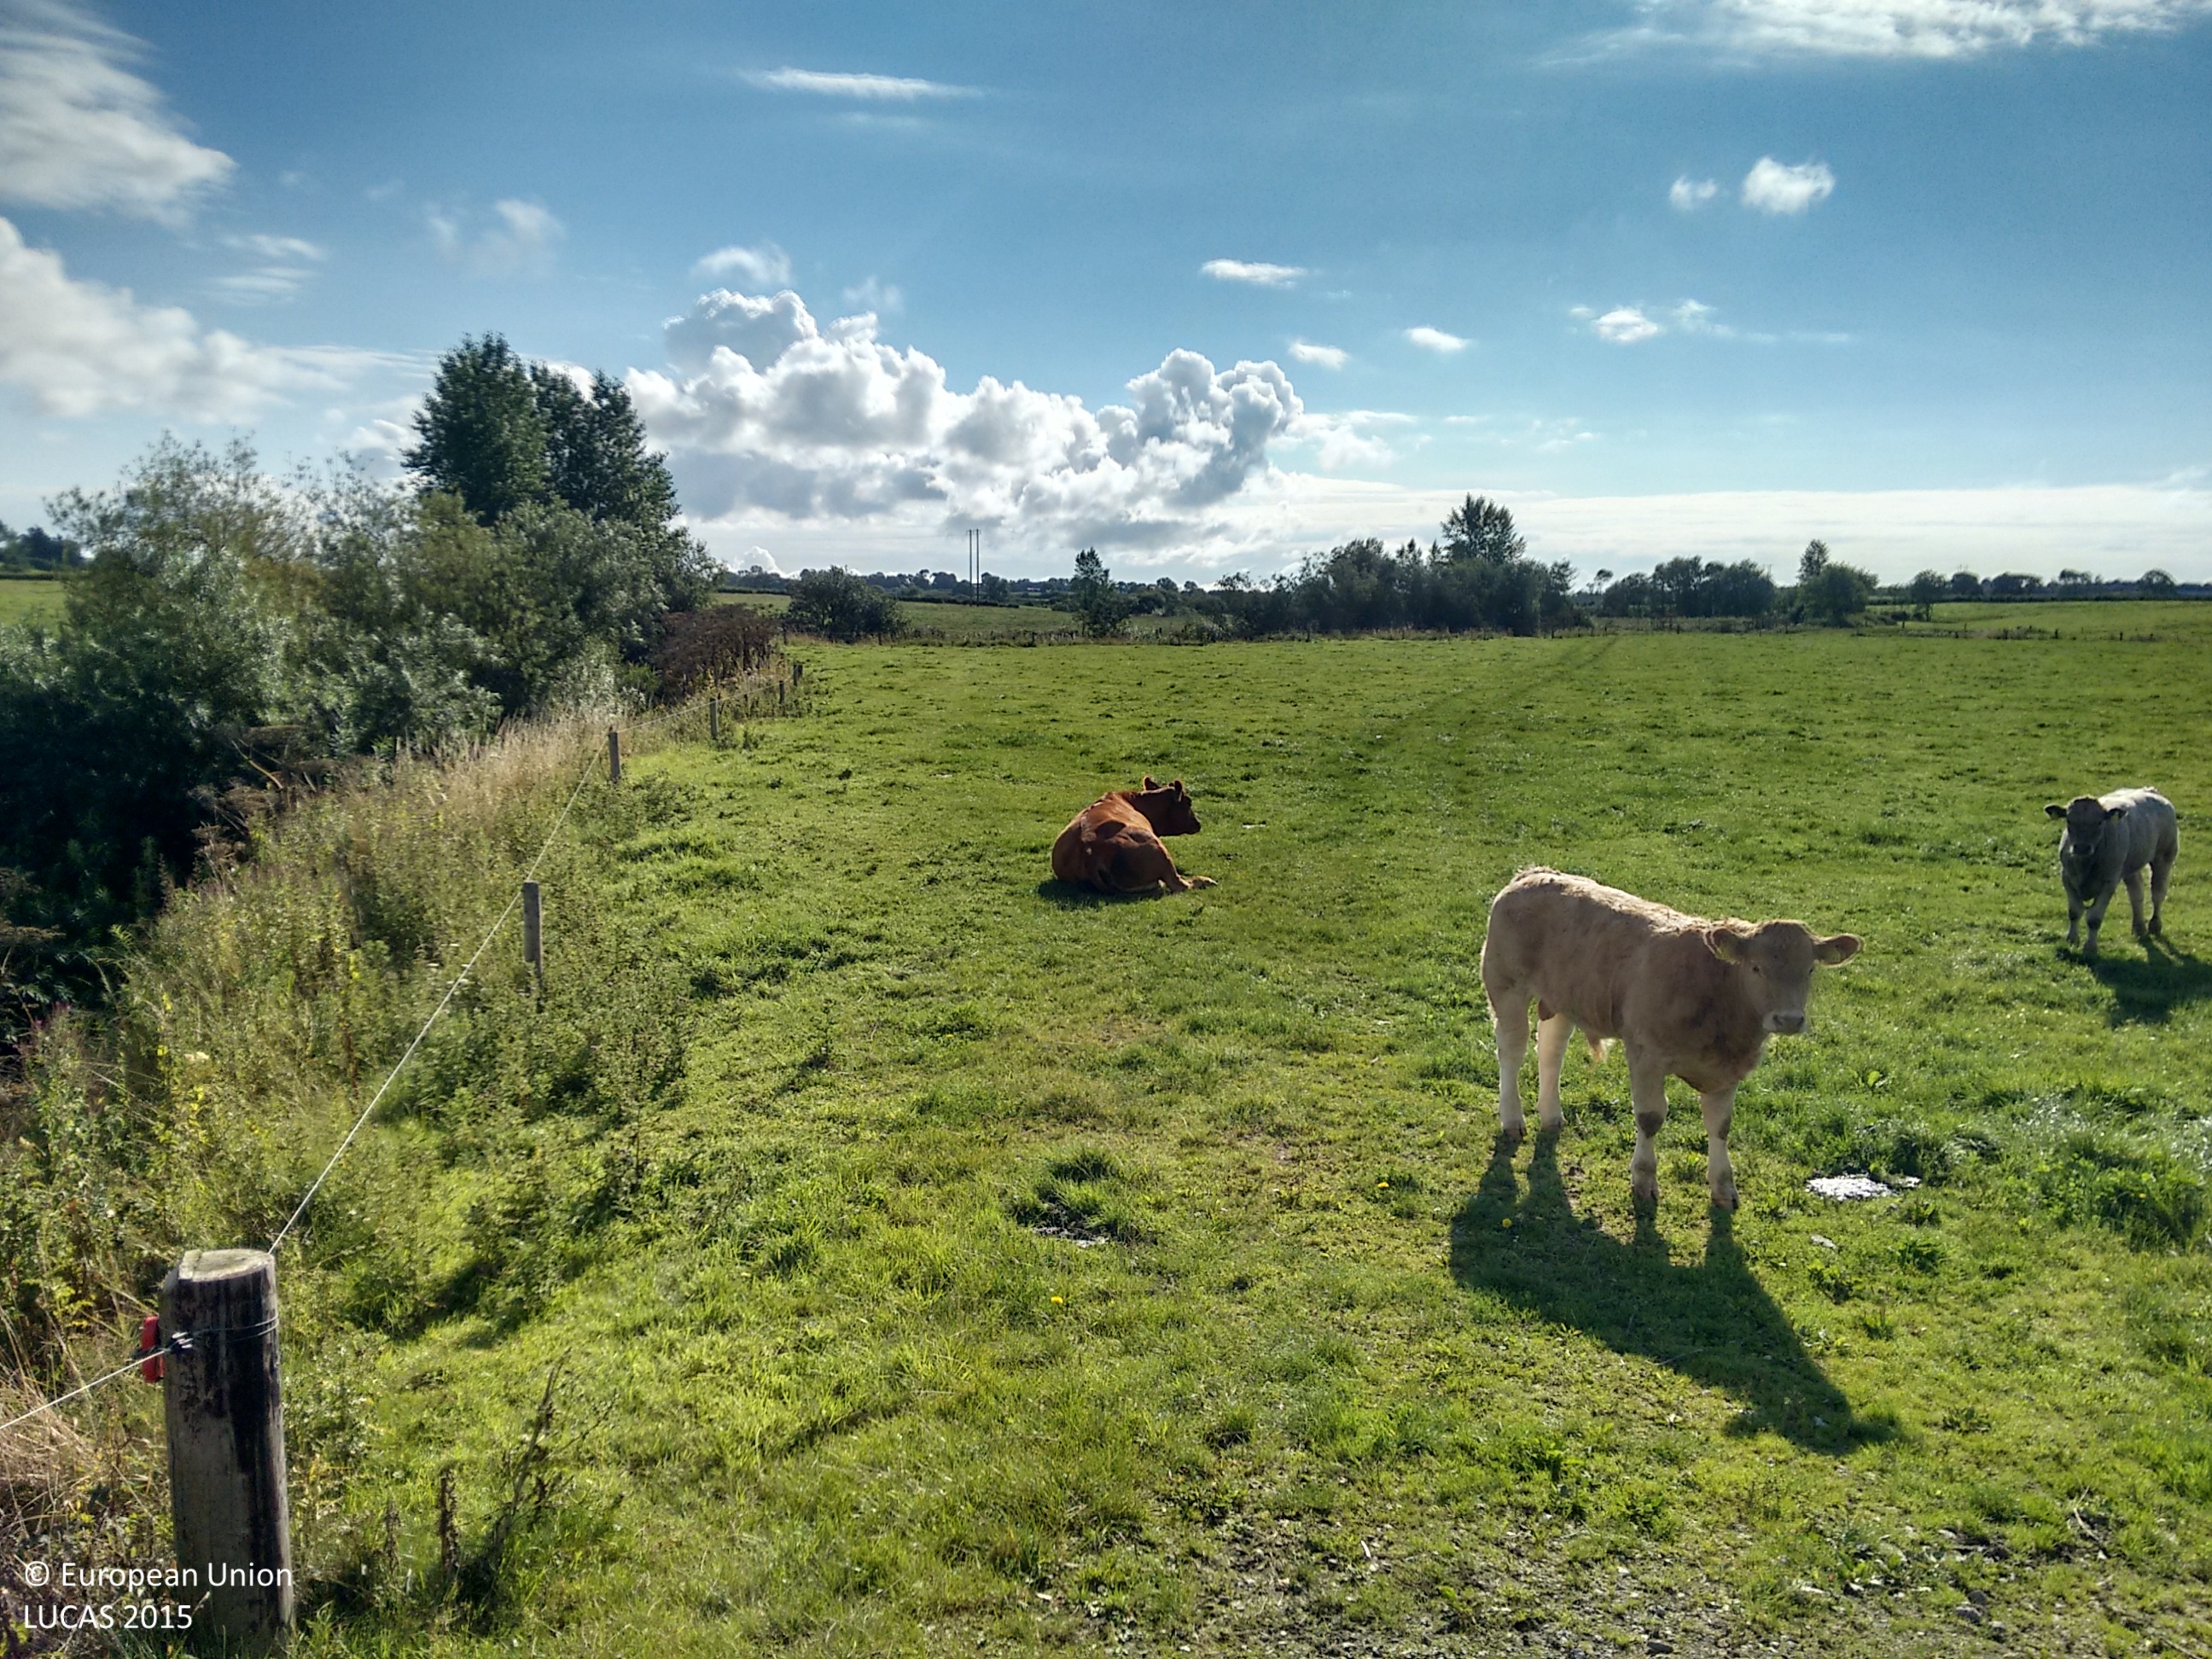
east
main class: Grassland
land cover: Grassland without tree/shrub cover
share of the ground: > 75 %
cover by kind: herbaceous plants 100 %
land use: Agriculture (excluding fallow land and kitchen gardens)
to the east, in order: Grassland without tree/shrub cover; Fences; Shruby margins; Rivers and streams; Shruby margins; Fences; Grassland without tree/shrub cover; Electric lines
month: August
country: IE
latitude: 52.5682
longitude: -8.2584
